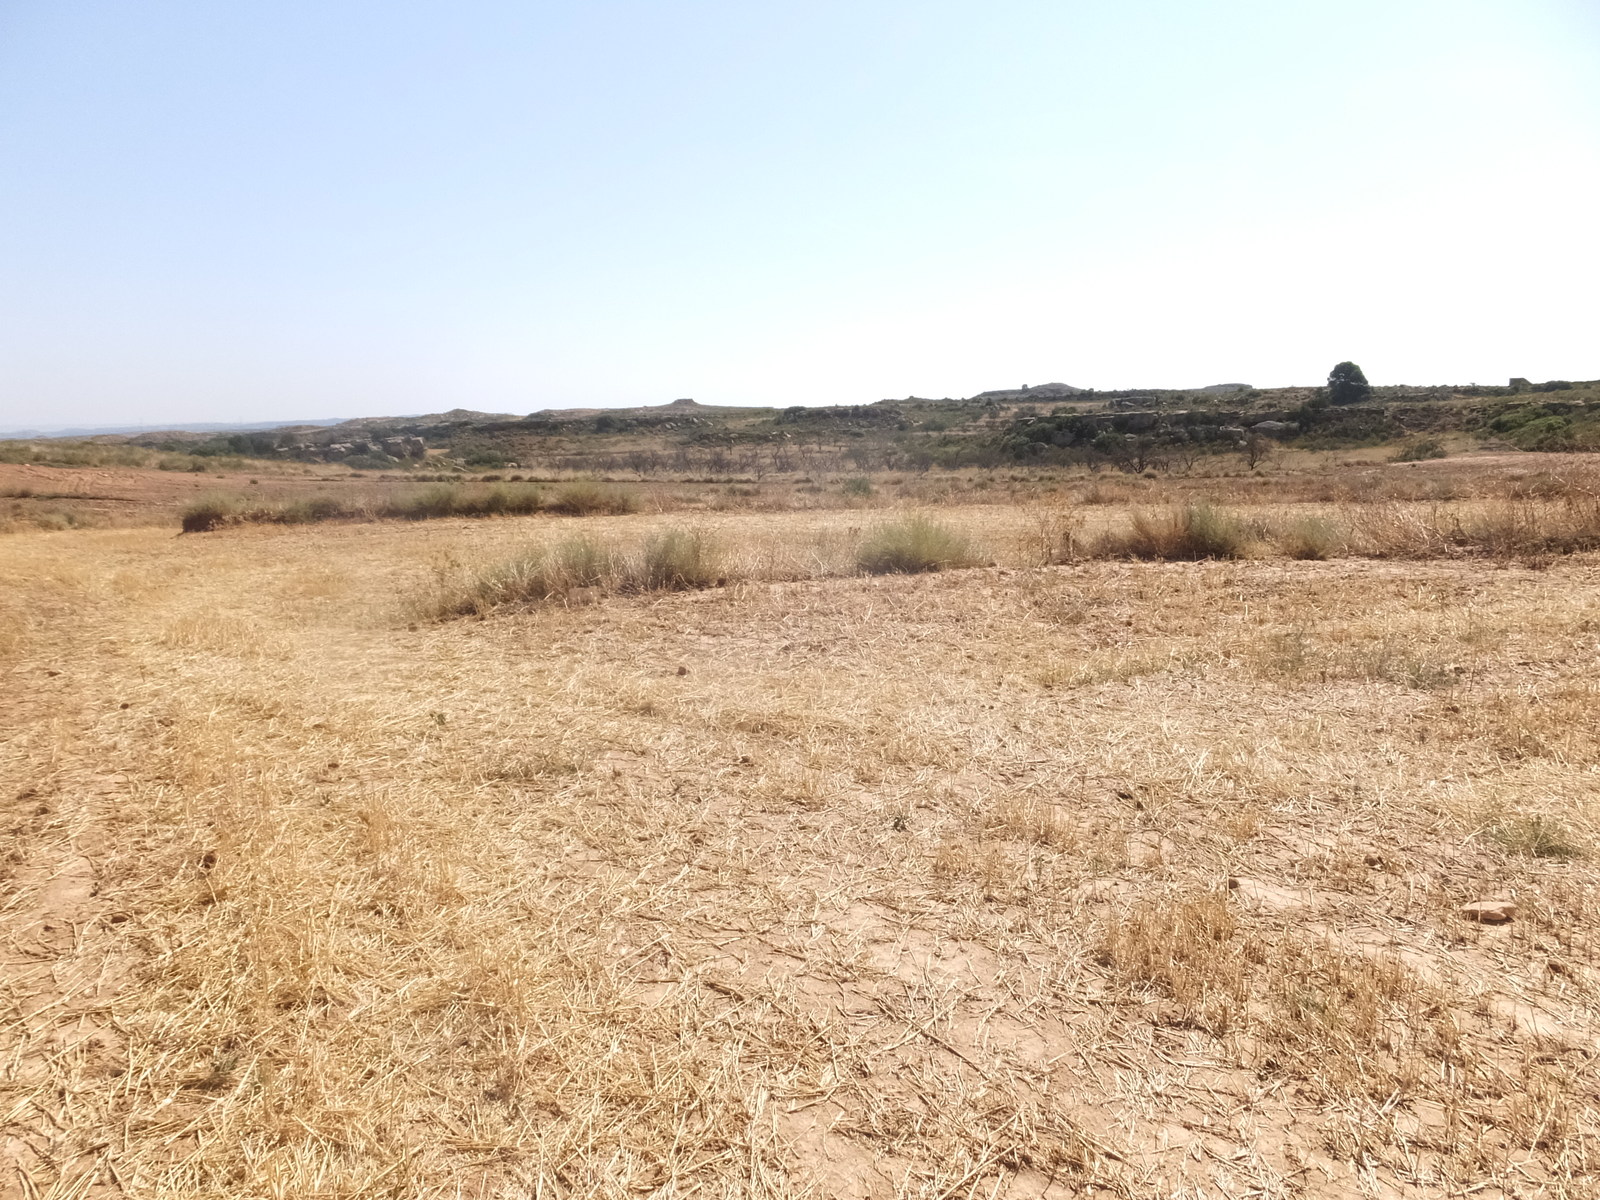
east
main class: Cropland
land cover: Barley
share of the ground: < 10 %
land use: Agriculture (excluding fallow land and kitchen gardens)
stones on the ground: < 10 %
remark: Harvested field
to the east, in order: Barley; Shruby margins; Barley; Shruby margins; Barley; Shruby margins; Other bare soil; Shruby margins; Other bare soil; Shruby margins; Other bare soil; Shruby margins; Nuts trees; Shrubland with sparse tree cover; Rock outcrops; Shrubland with sparse tree cover
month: July
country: ES
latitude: 41.1695
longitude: -0.0598
